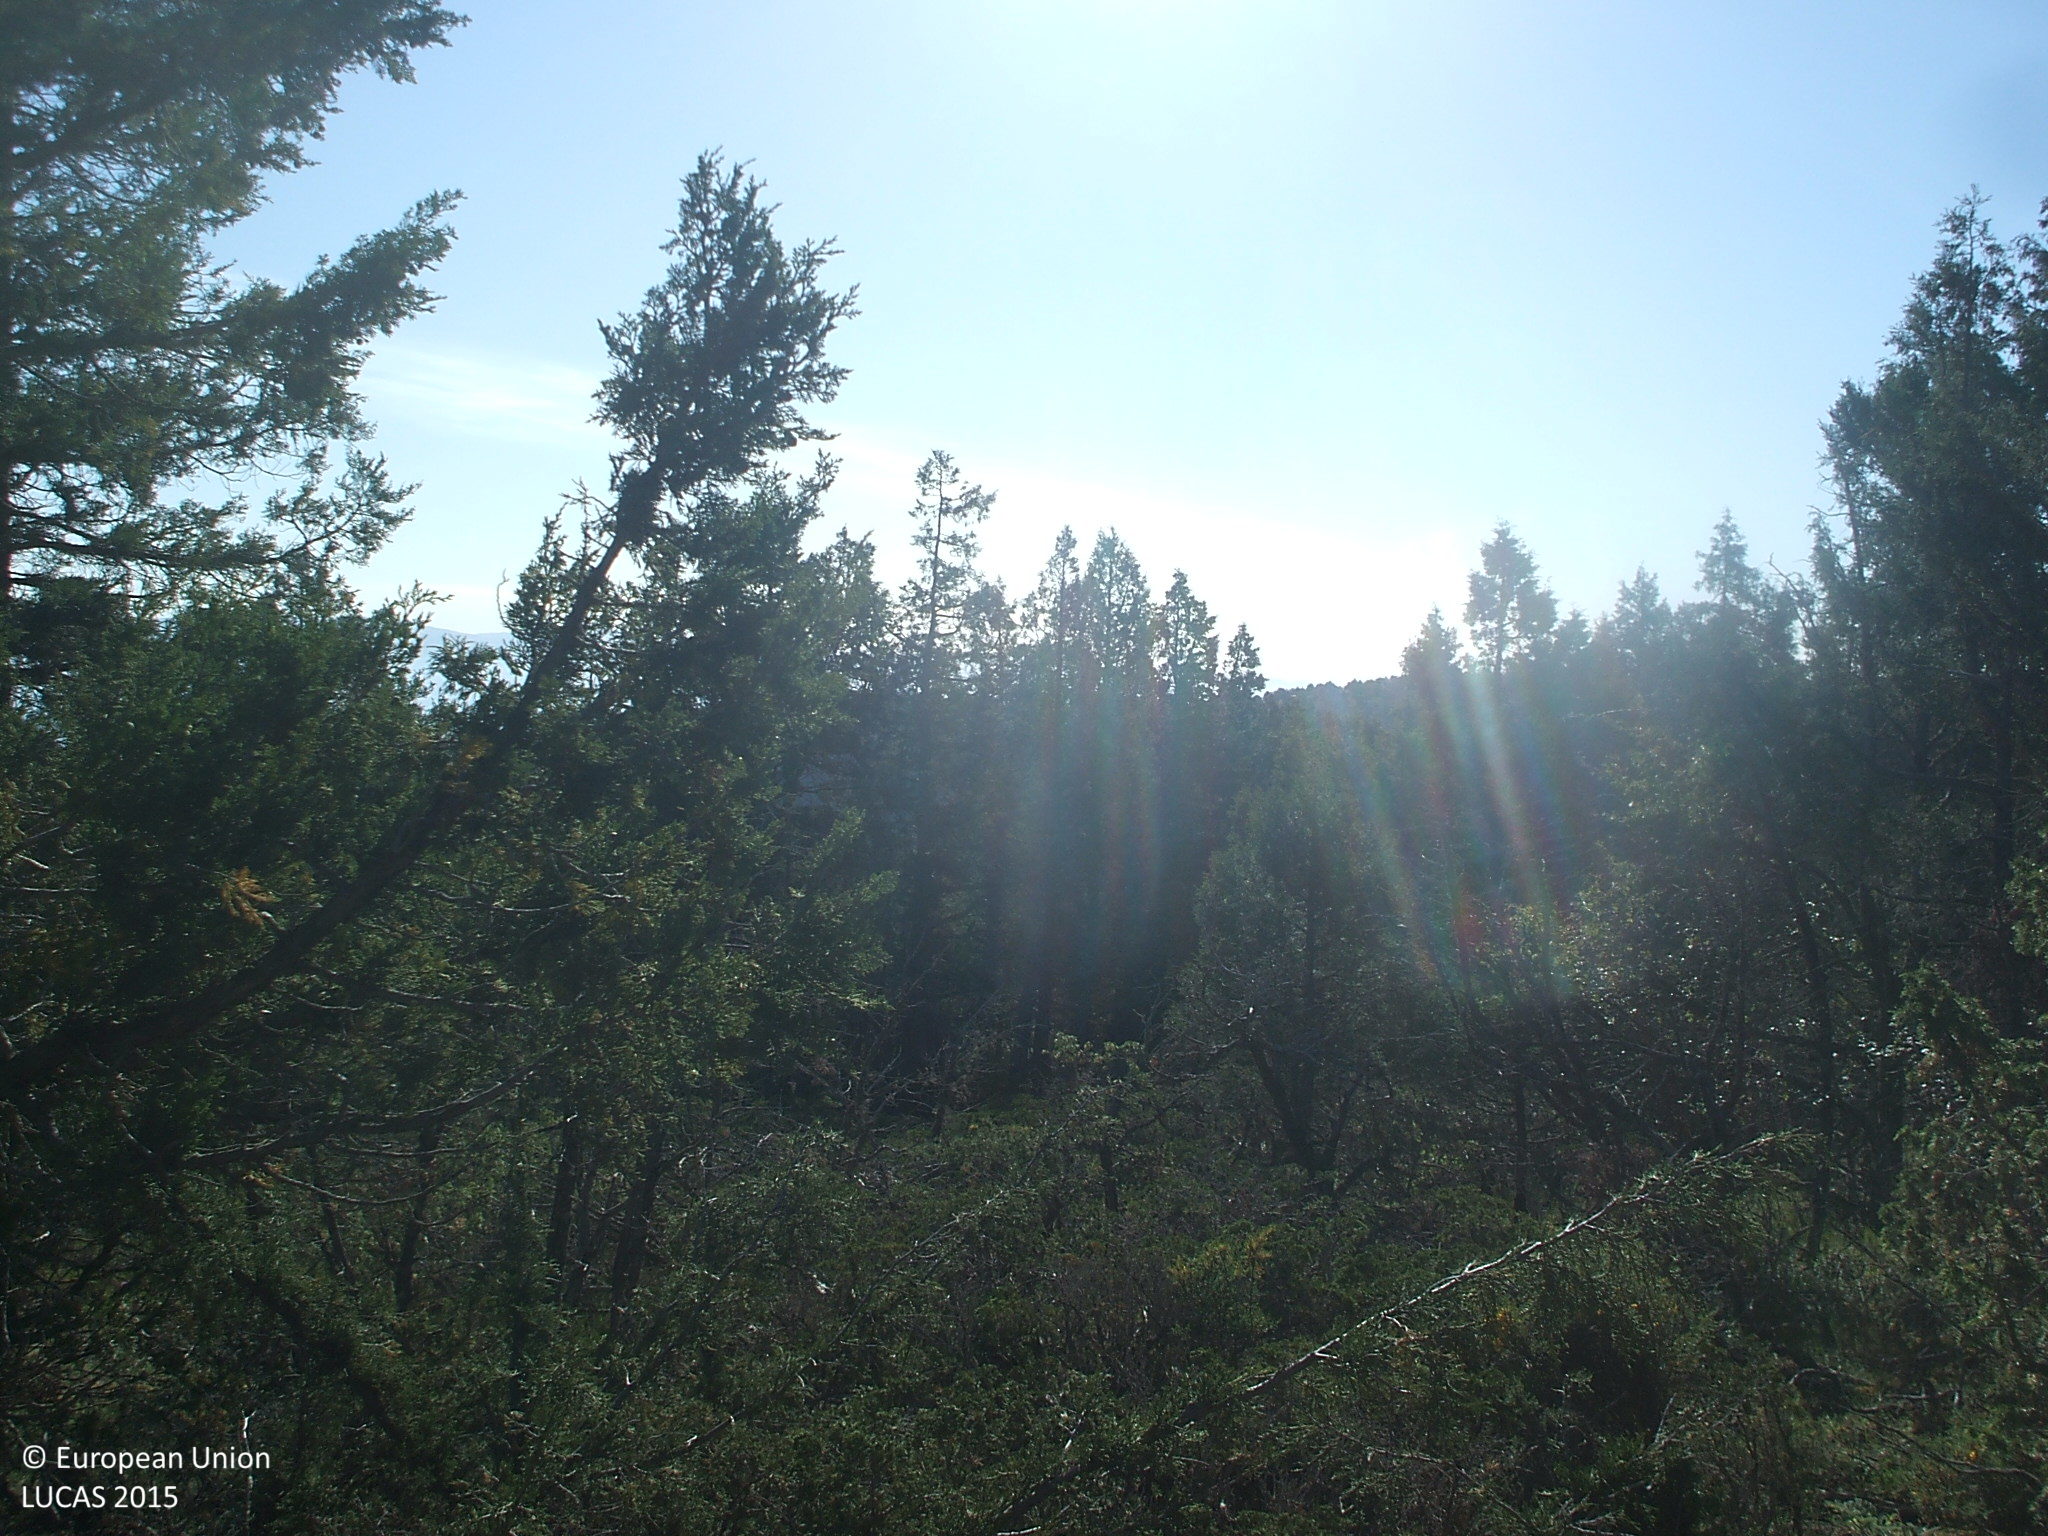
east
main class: Woodland
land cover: Other coniferous woodland
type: coniferous forest of the mediterranean region
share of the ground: 50 - 75 %
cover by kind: coniferous forest trees 60 %, herbaceous plants 40 %
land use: Semi-natural and natural areas not in use
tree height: > 5 m
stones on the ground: > 50 %
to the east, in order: Other coniferous woodland; Other bare soil
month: May
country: ES
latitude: 40.1440
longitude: -0.9591
